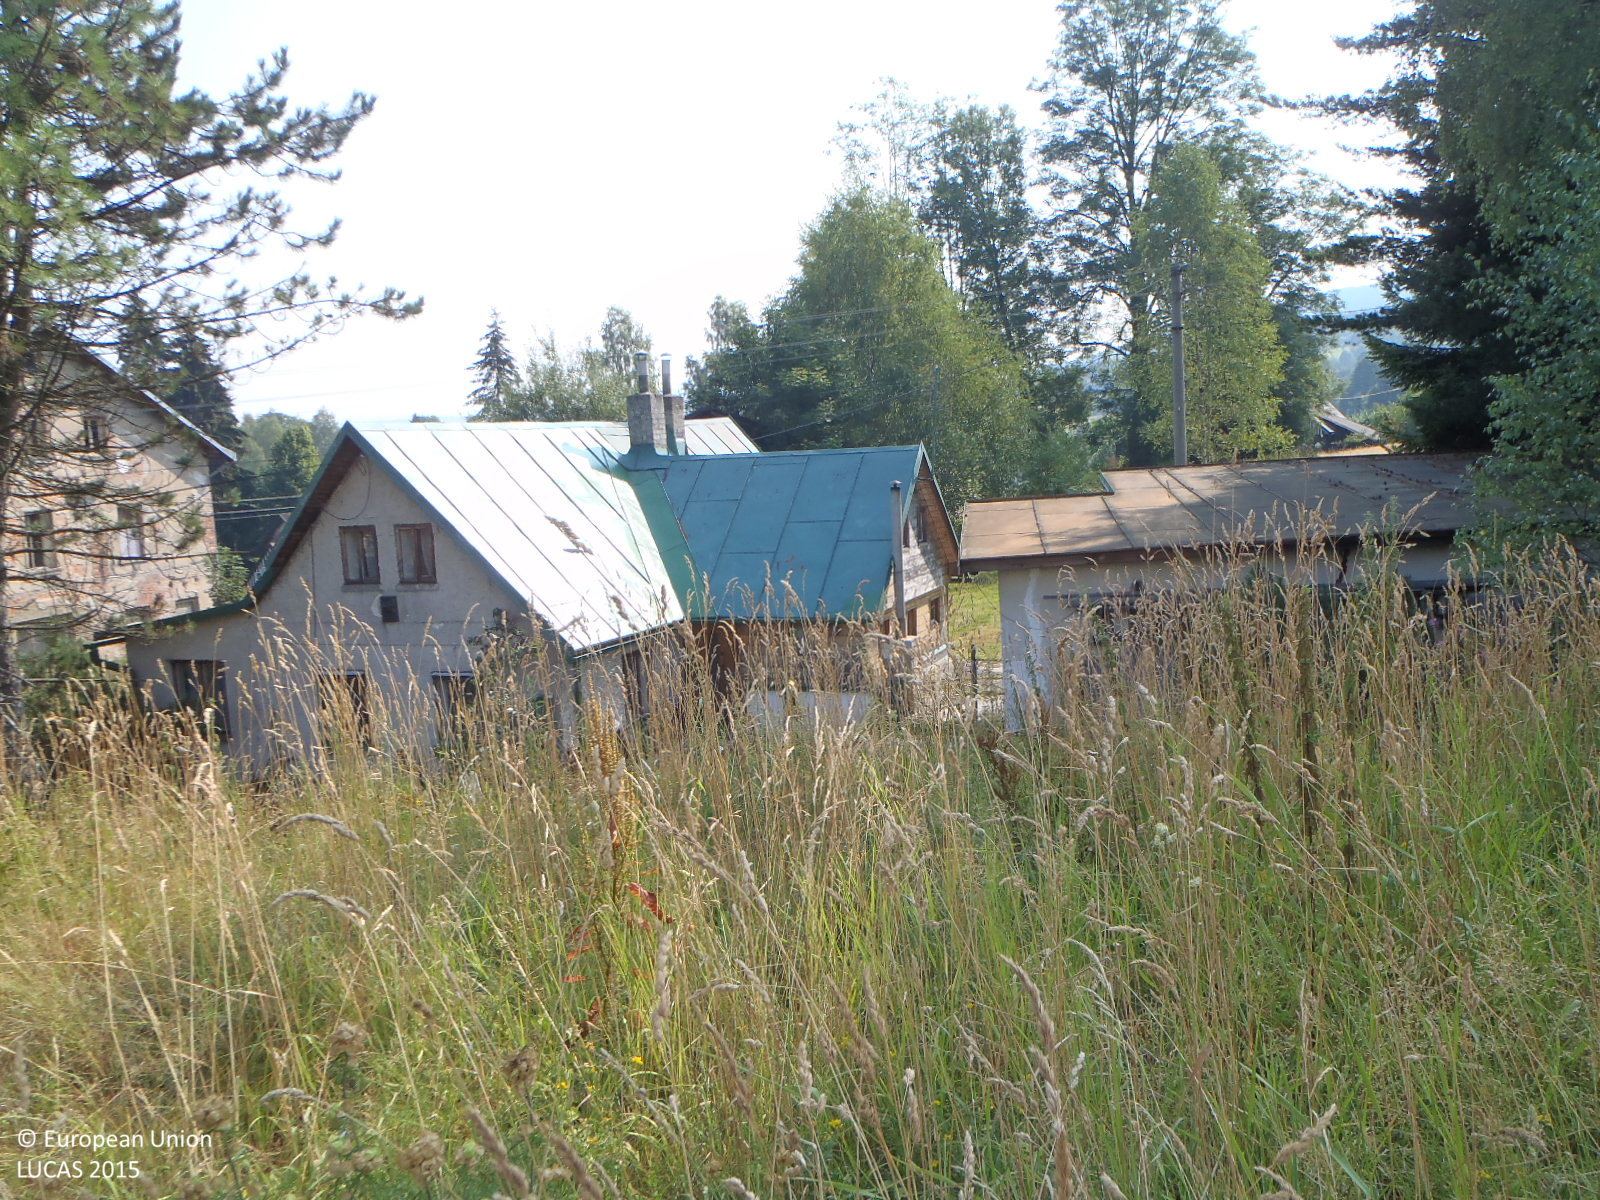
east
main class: Grassland
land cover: Spontaneously vegetated surfaces
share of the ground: > 75 %
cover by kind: herbaceous plants 100 %
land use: Coal, oil and metal processing
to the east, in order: Spontaneously vegetated surfaces; Rivers and streams; Artificial constructions in urban areas
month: August
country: CZ
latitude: 50.7296
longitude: 15.2596
